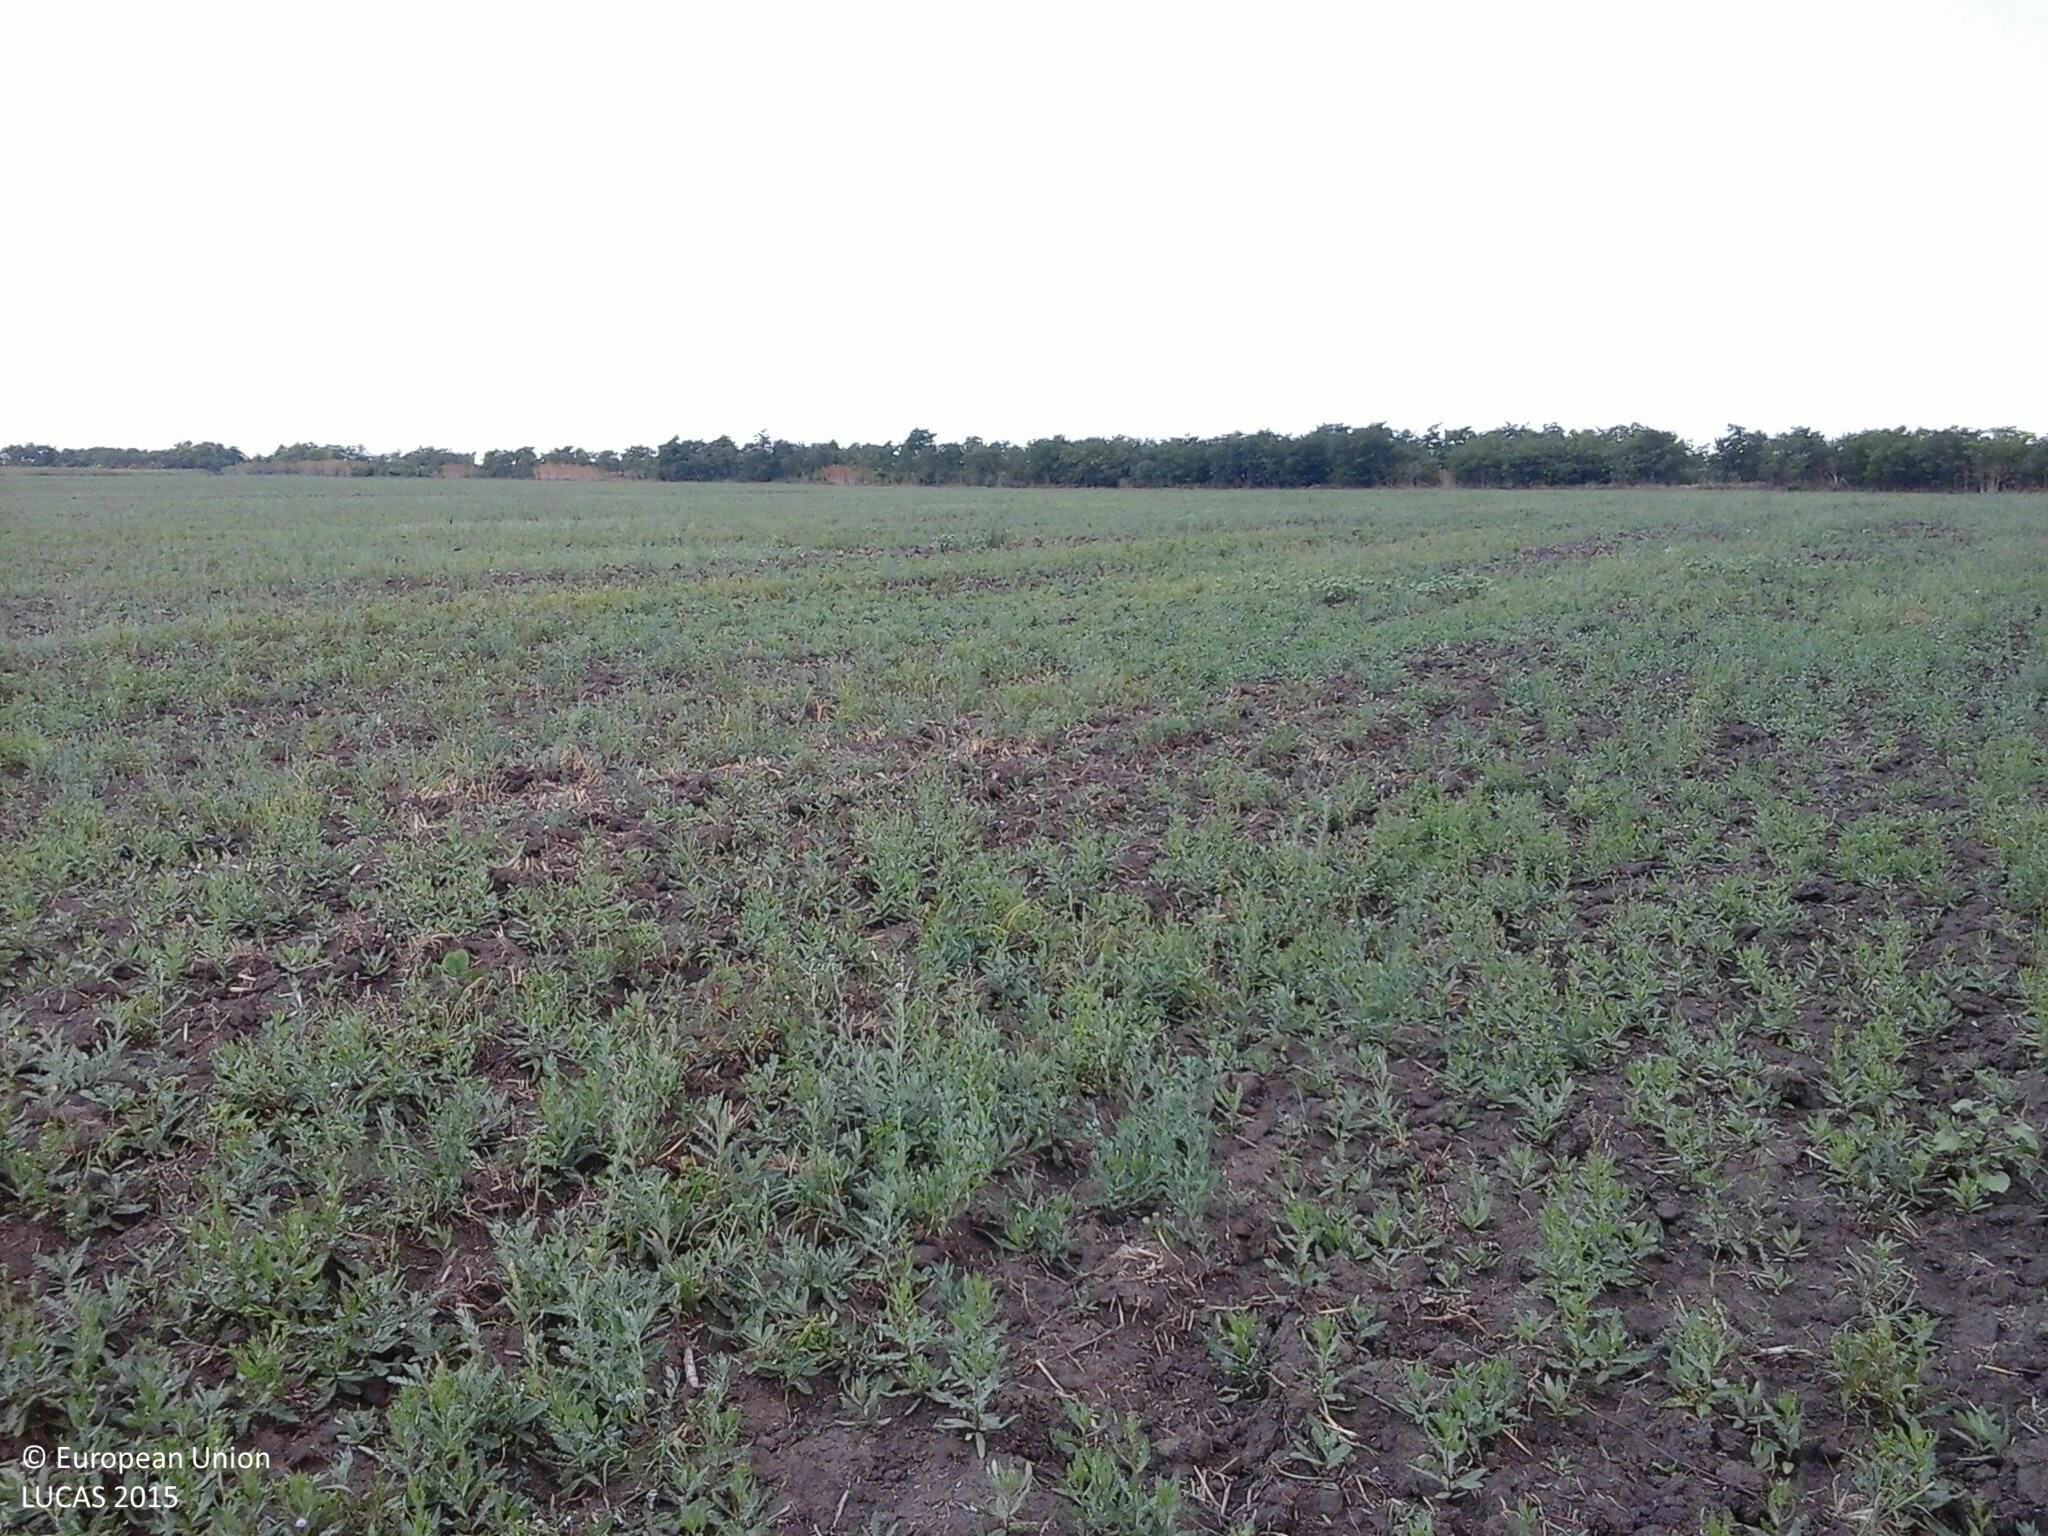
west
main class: Grassland
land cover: Spontaneously vegetated surfaces
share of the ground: 50 - 75 %
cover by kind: herbaceous plants 60 %, unconsolidated bare surface 40 %
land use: Fallow land
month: August
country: HU
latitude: 47.6030
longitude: 20.9569
